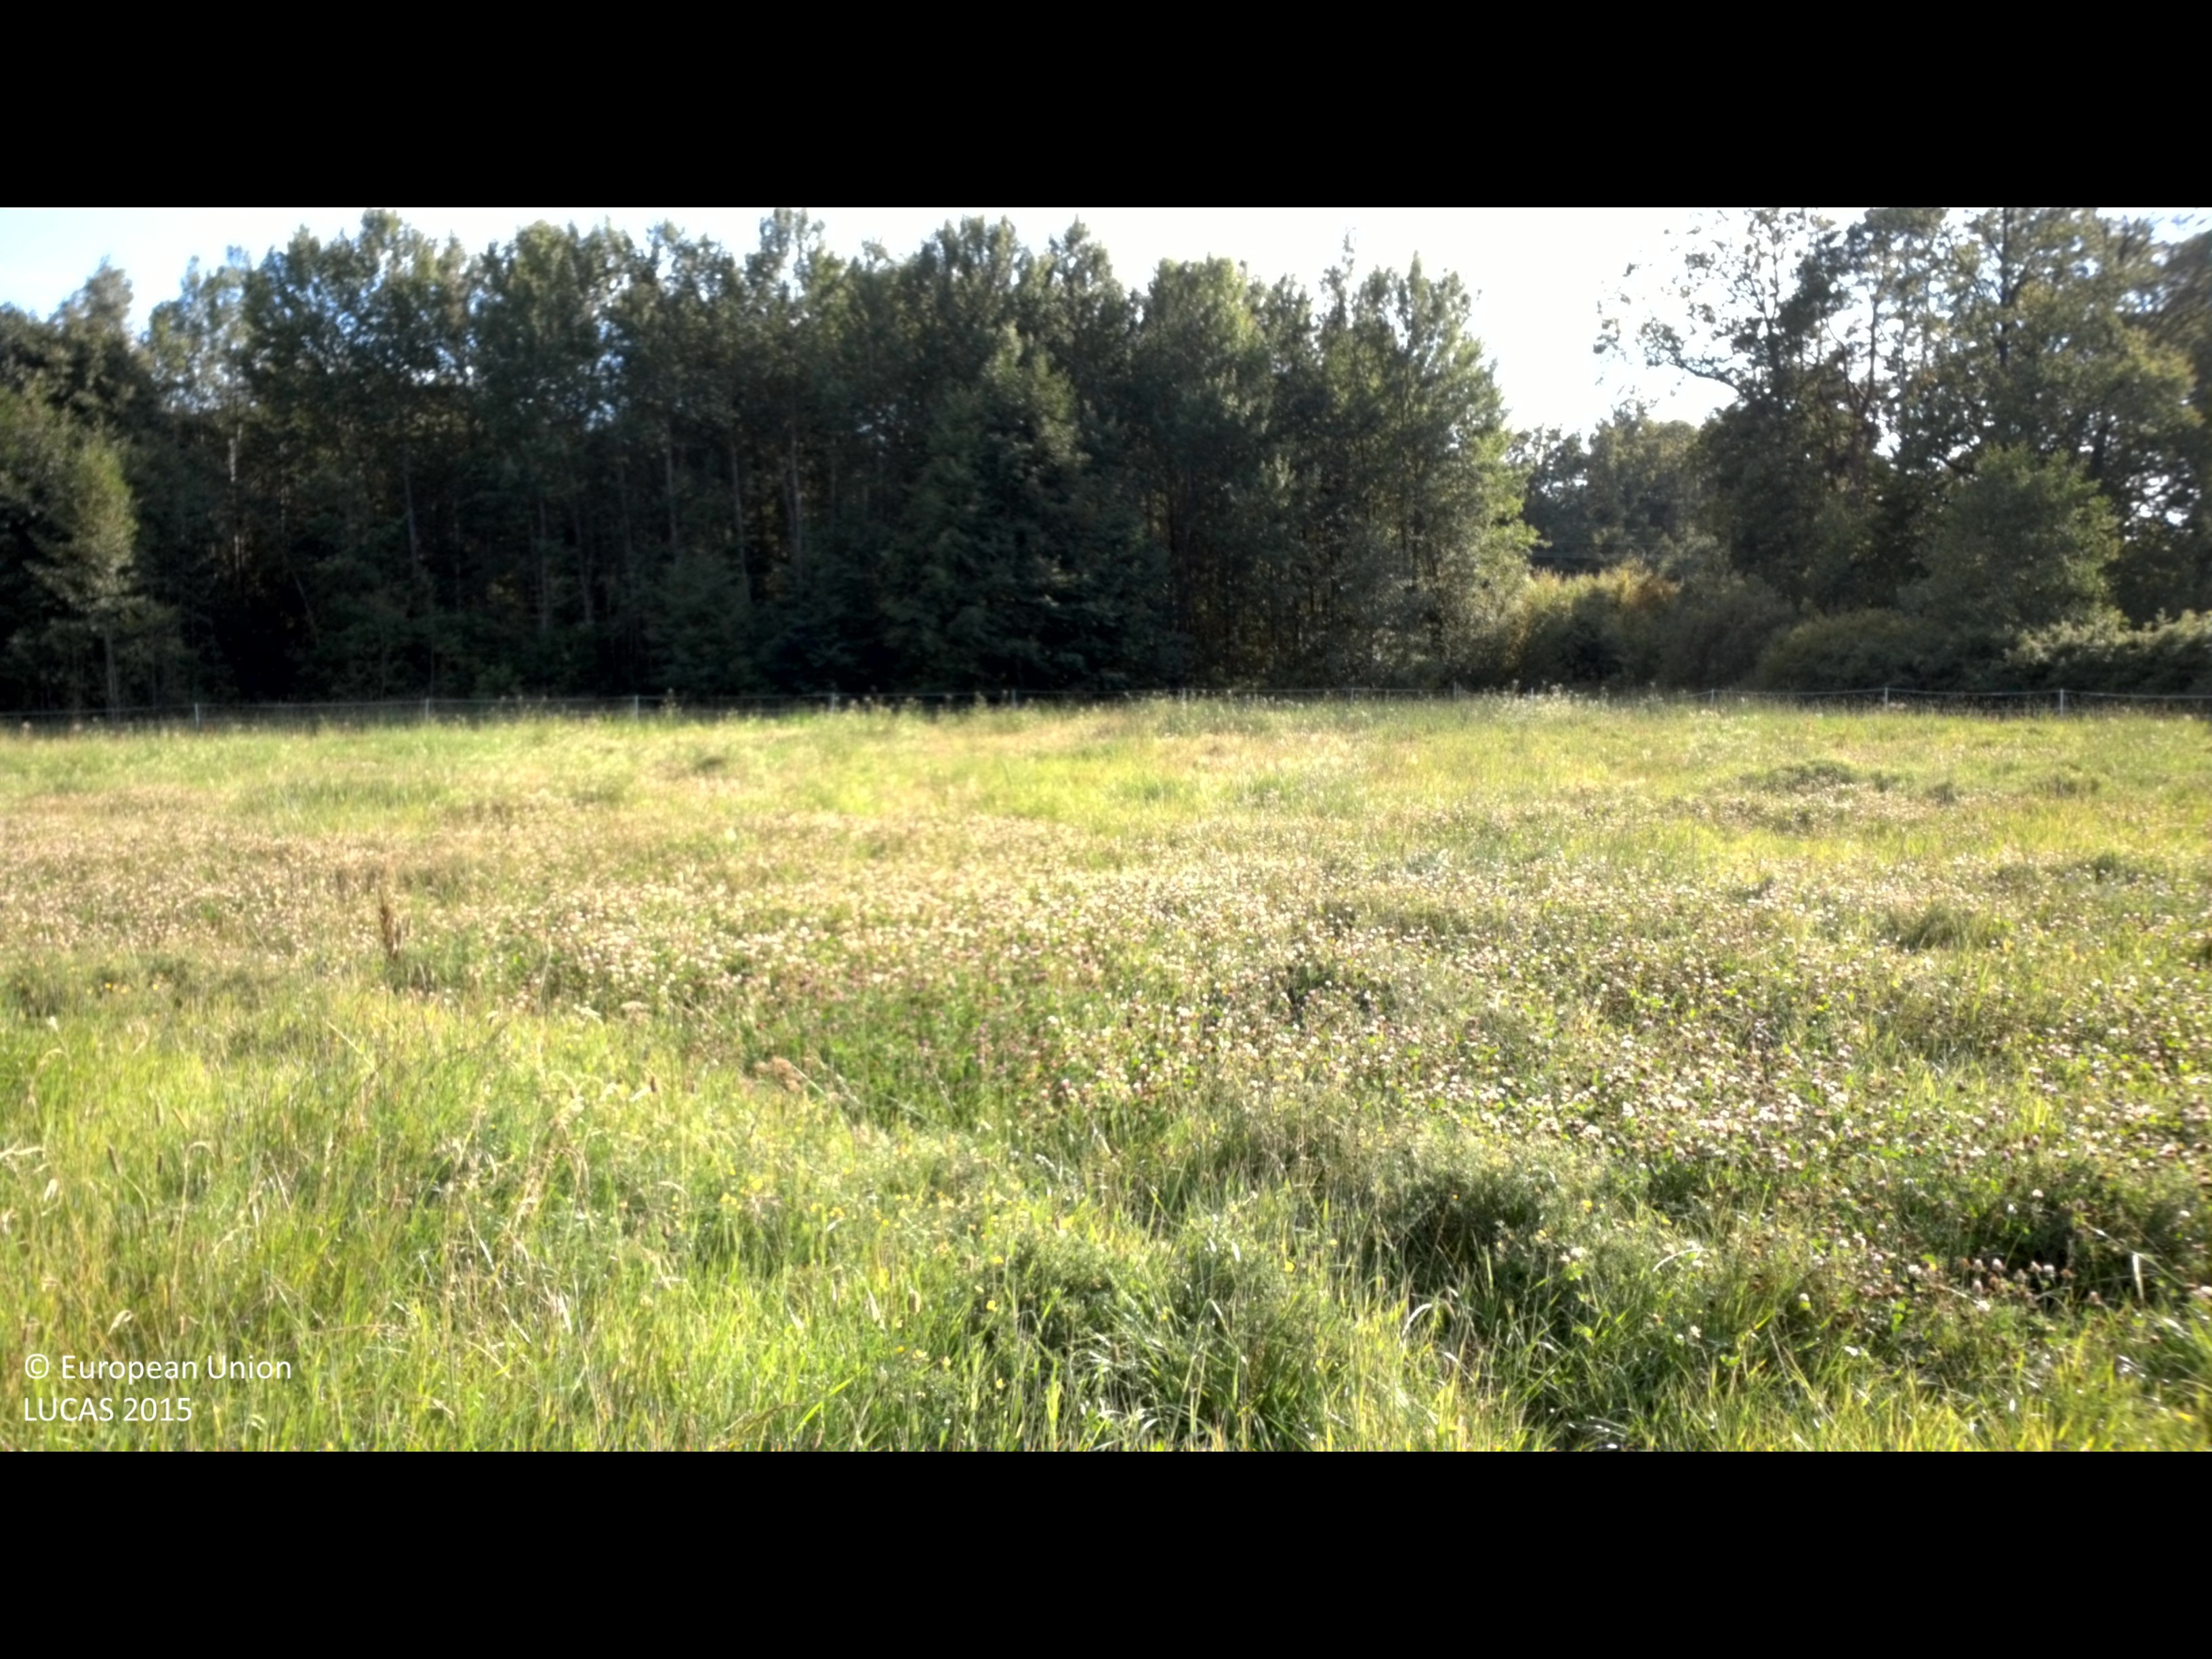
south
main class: Grassland
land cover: Grassland without tree/shrub cover
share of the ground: > 75 %
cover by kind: herbaceous plants 100 %
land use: Agriculture (excluding fallow land and kitchen gardens)
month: August
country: SE
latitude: 56.1923
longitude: 14.6877
